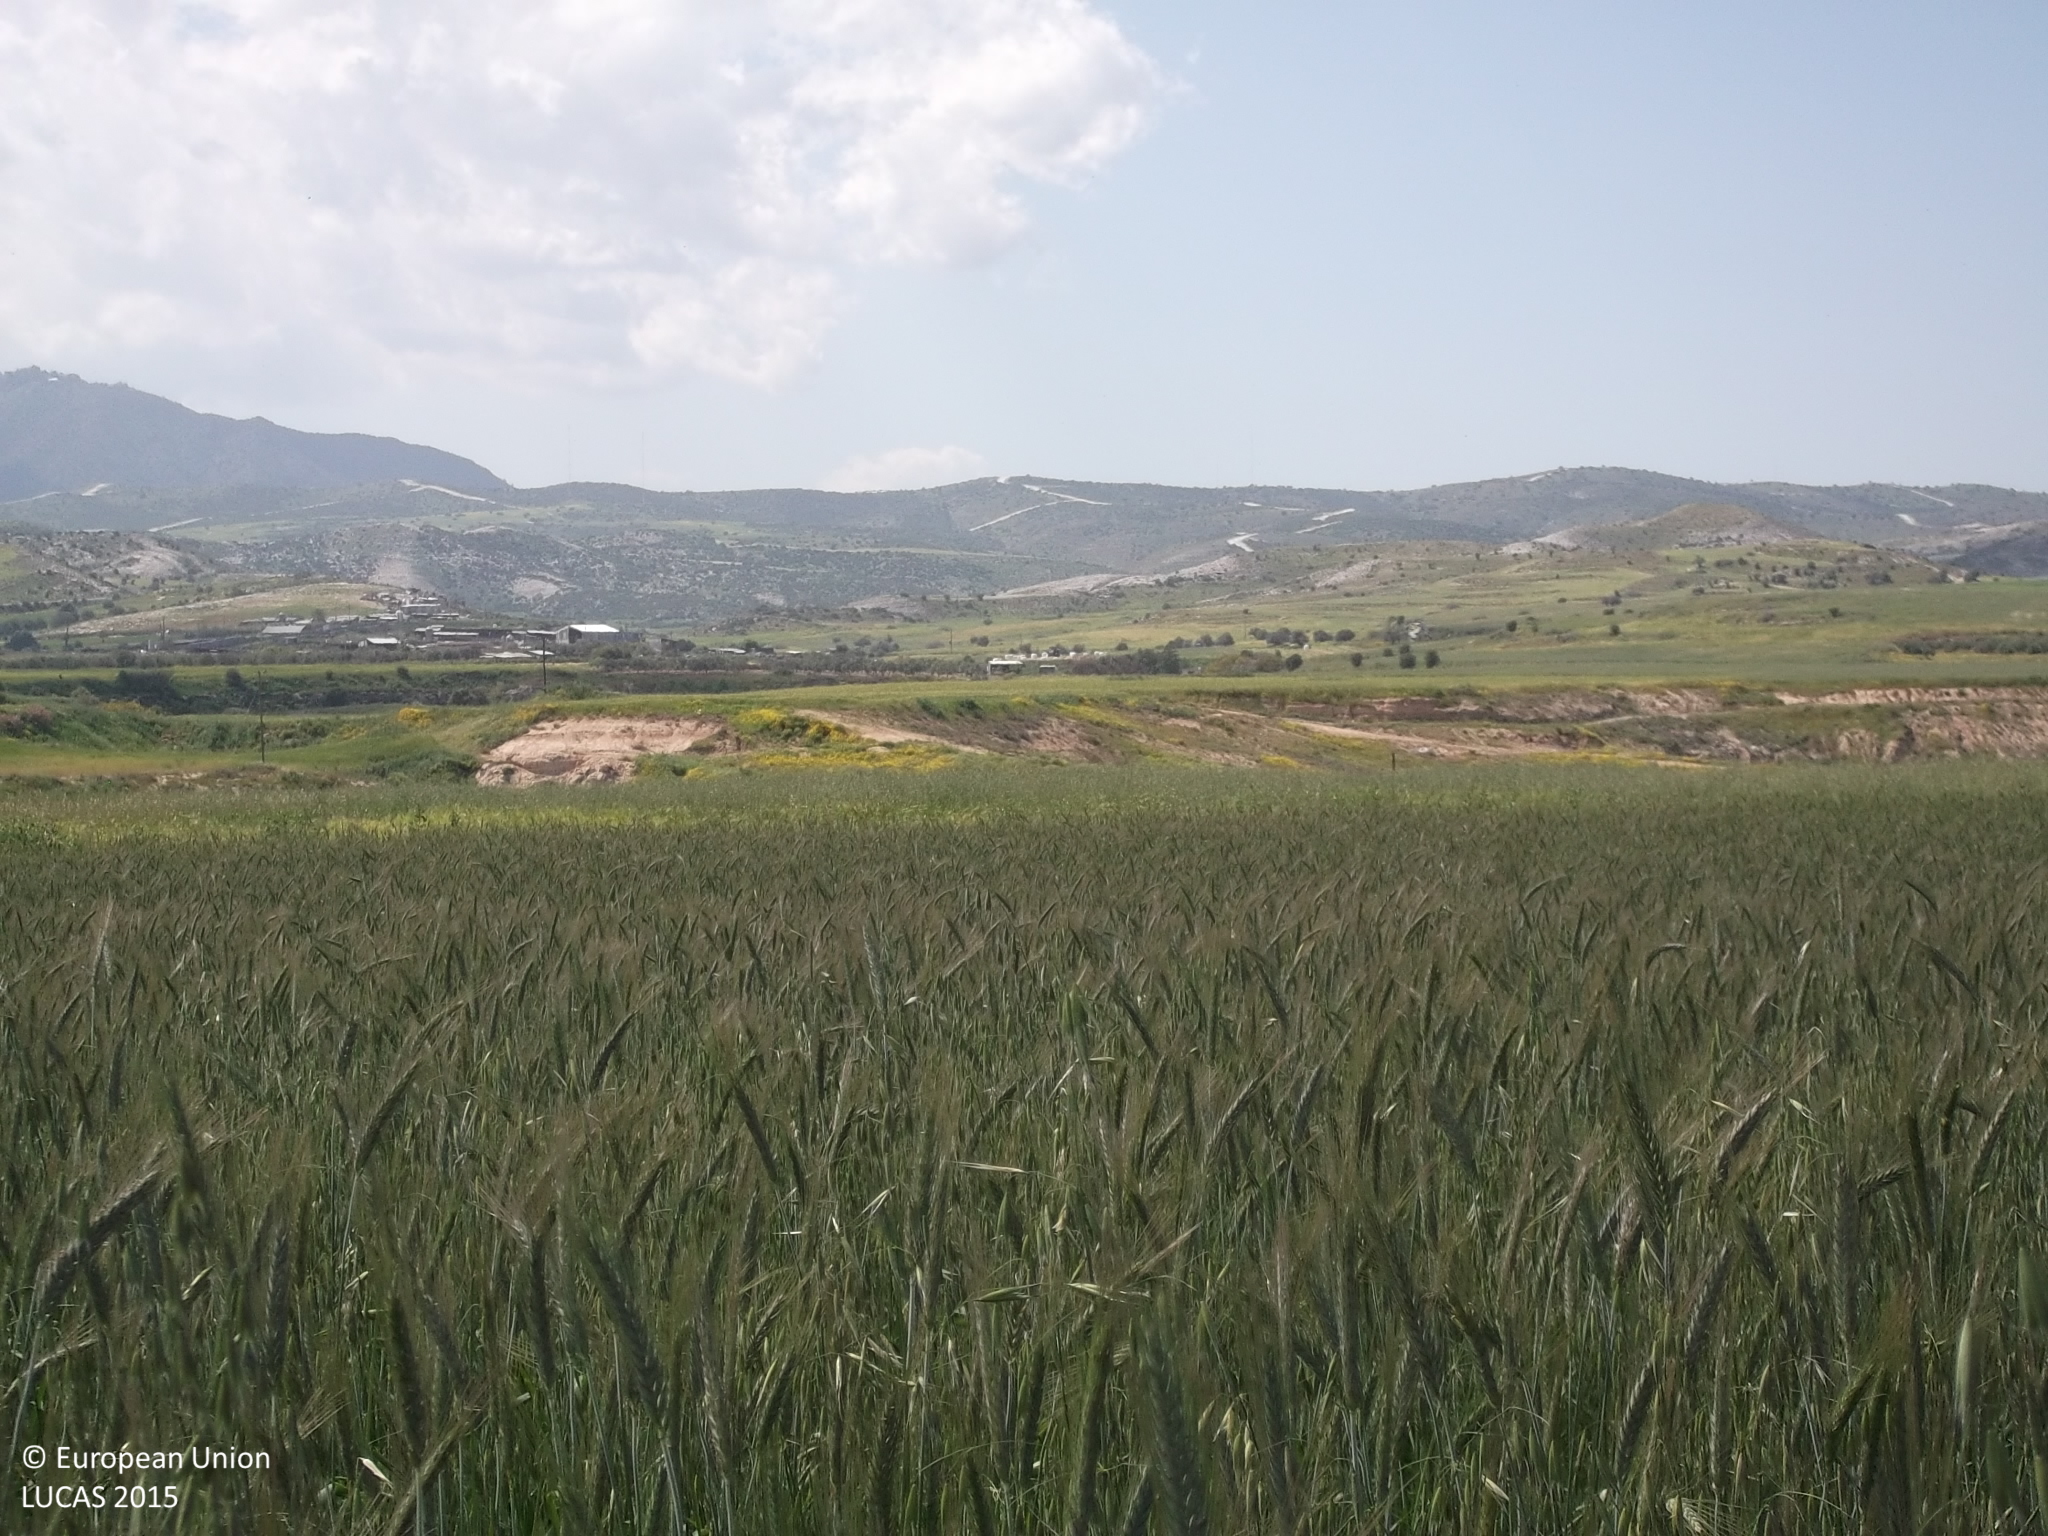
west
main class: Cropland
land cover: Common wheat
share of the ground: > 75 %
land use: Agriculture (excluding fallow land and kitchen gardens)
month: April
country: CY
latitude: 34.8997
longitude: 33.5342
